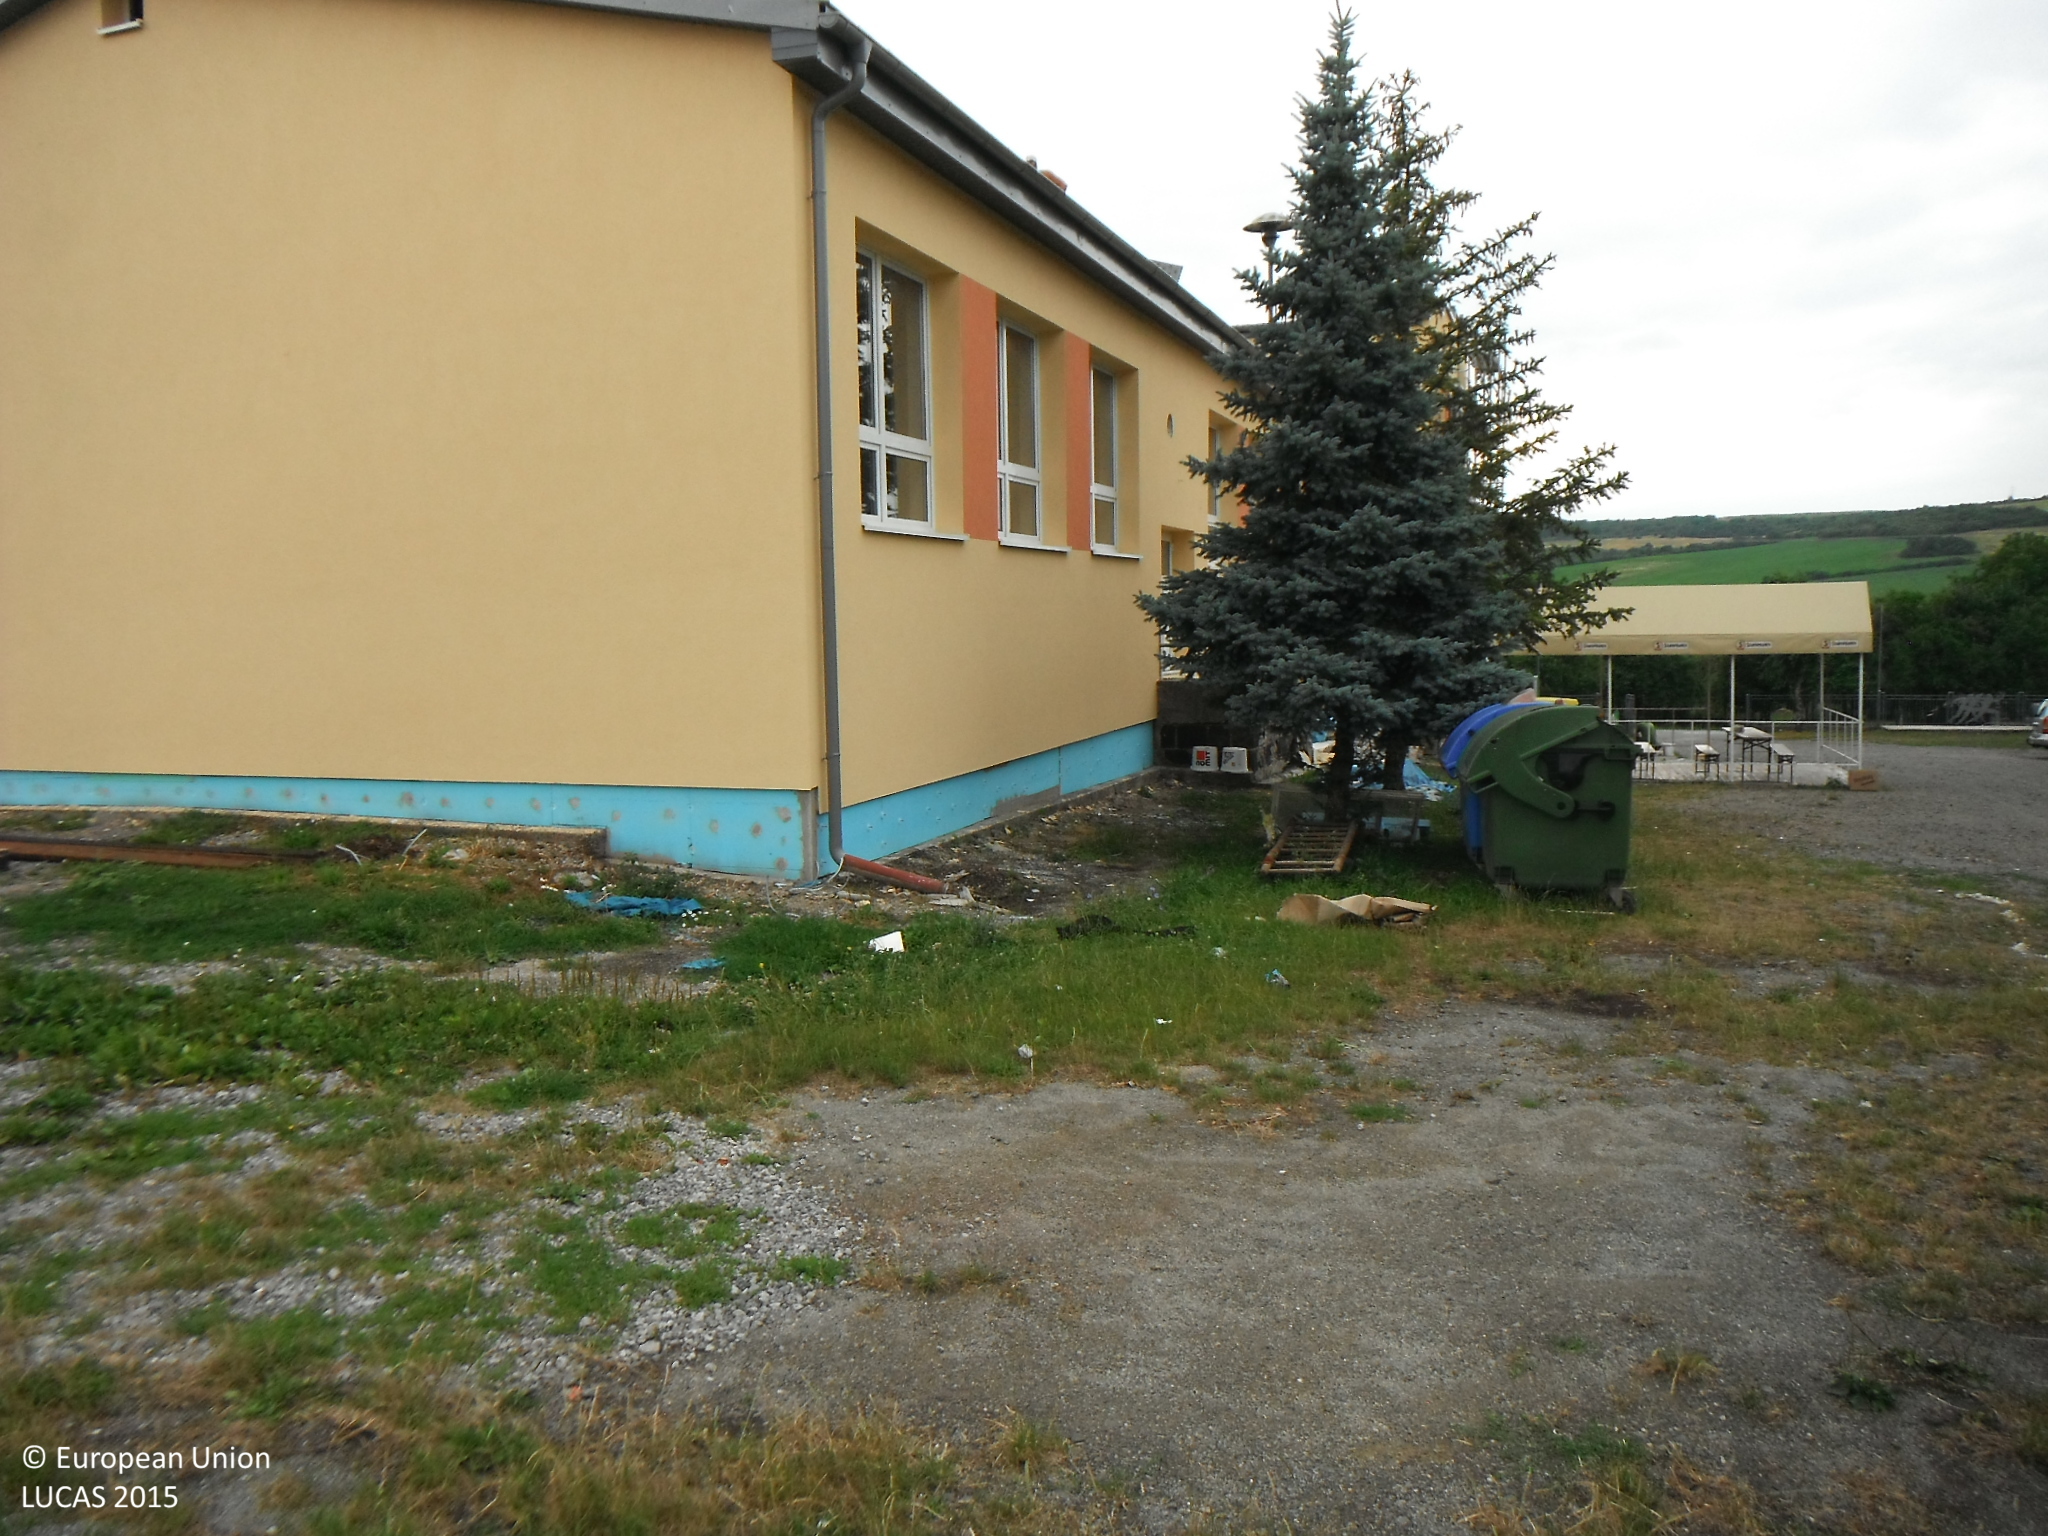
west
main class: Grassland
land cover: Grassland without tree/shrub cover
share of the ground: > 75 %
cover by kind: herbaceous plants 100 %
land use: Community services
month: July
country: SK
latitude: 48.6646
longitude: 21.4109
